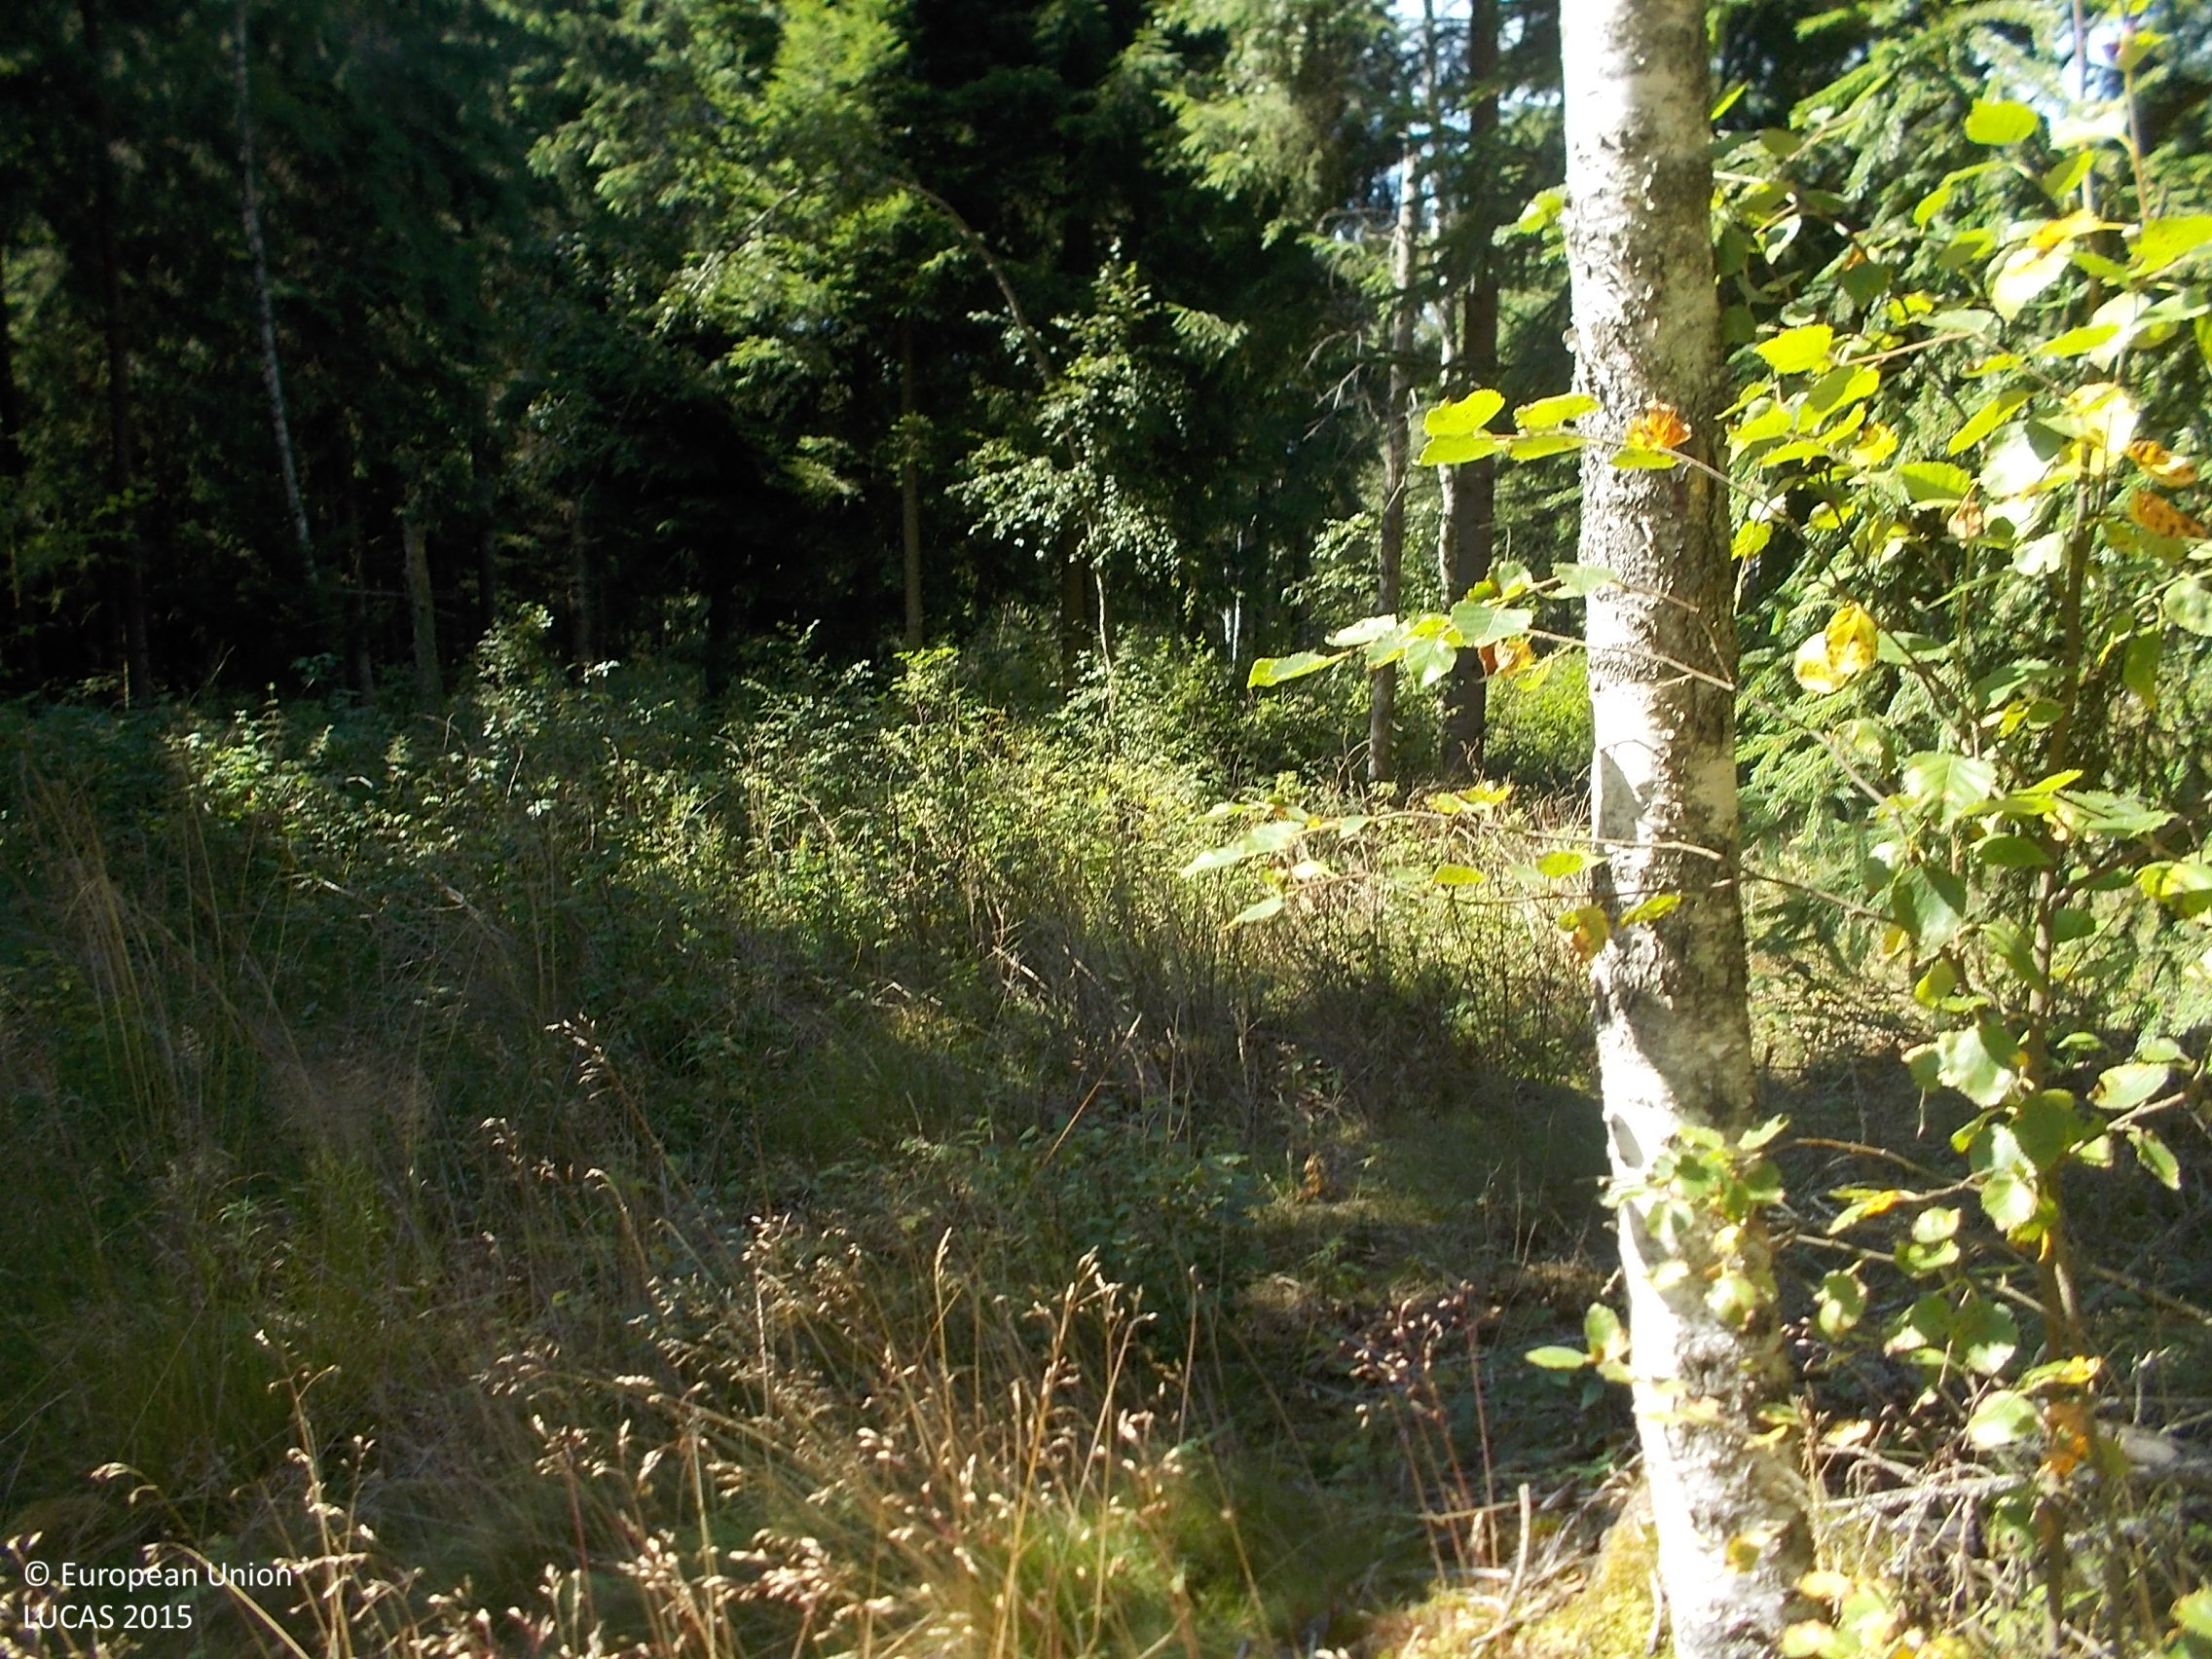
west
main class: Woodland
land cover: Spruce dominated coniferous woodland
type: boreal forest
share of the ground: > 75 %
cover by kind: coniferous forest trees 75 %, shrubs 10 %, herbaceous plants 10 %, lichens and mosses 5 %
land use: Forestry
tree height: > 5 m
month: August
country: SE
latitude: 57.5869
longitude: 13.2239
